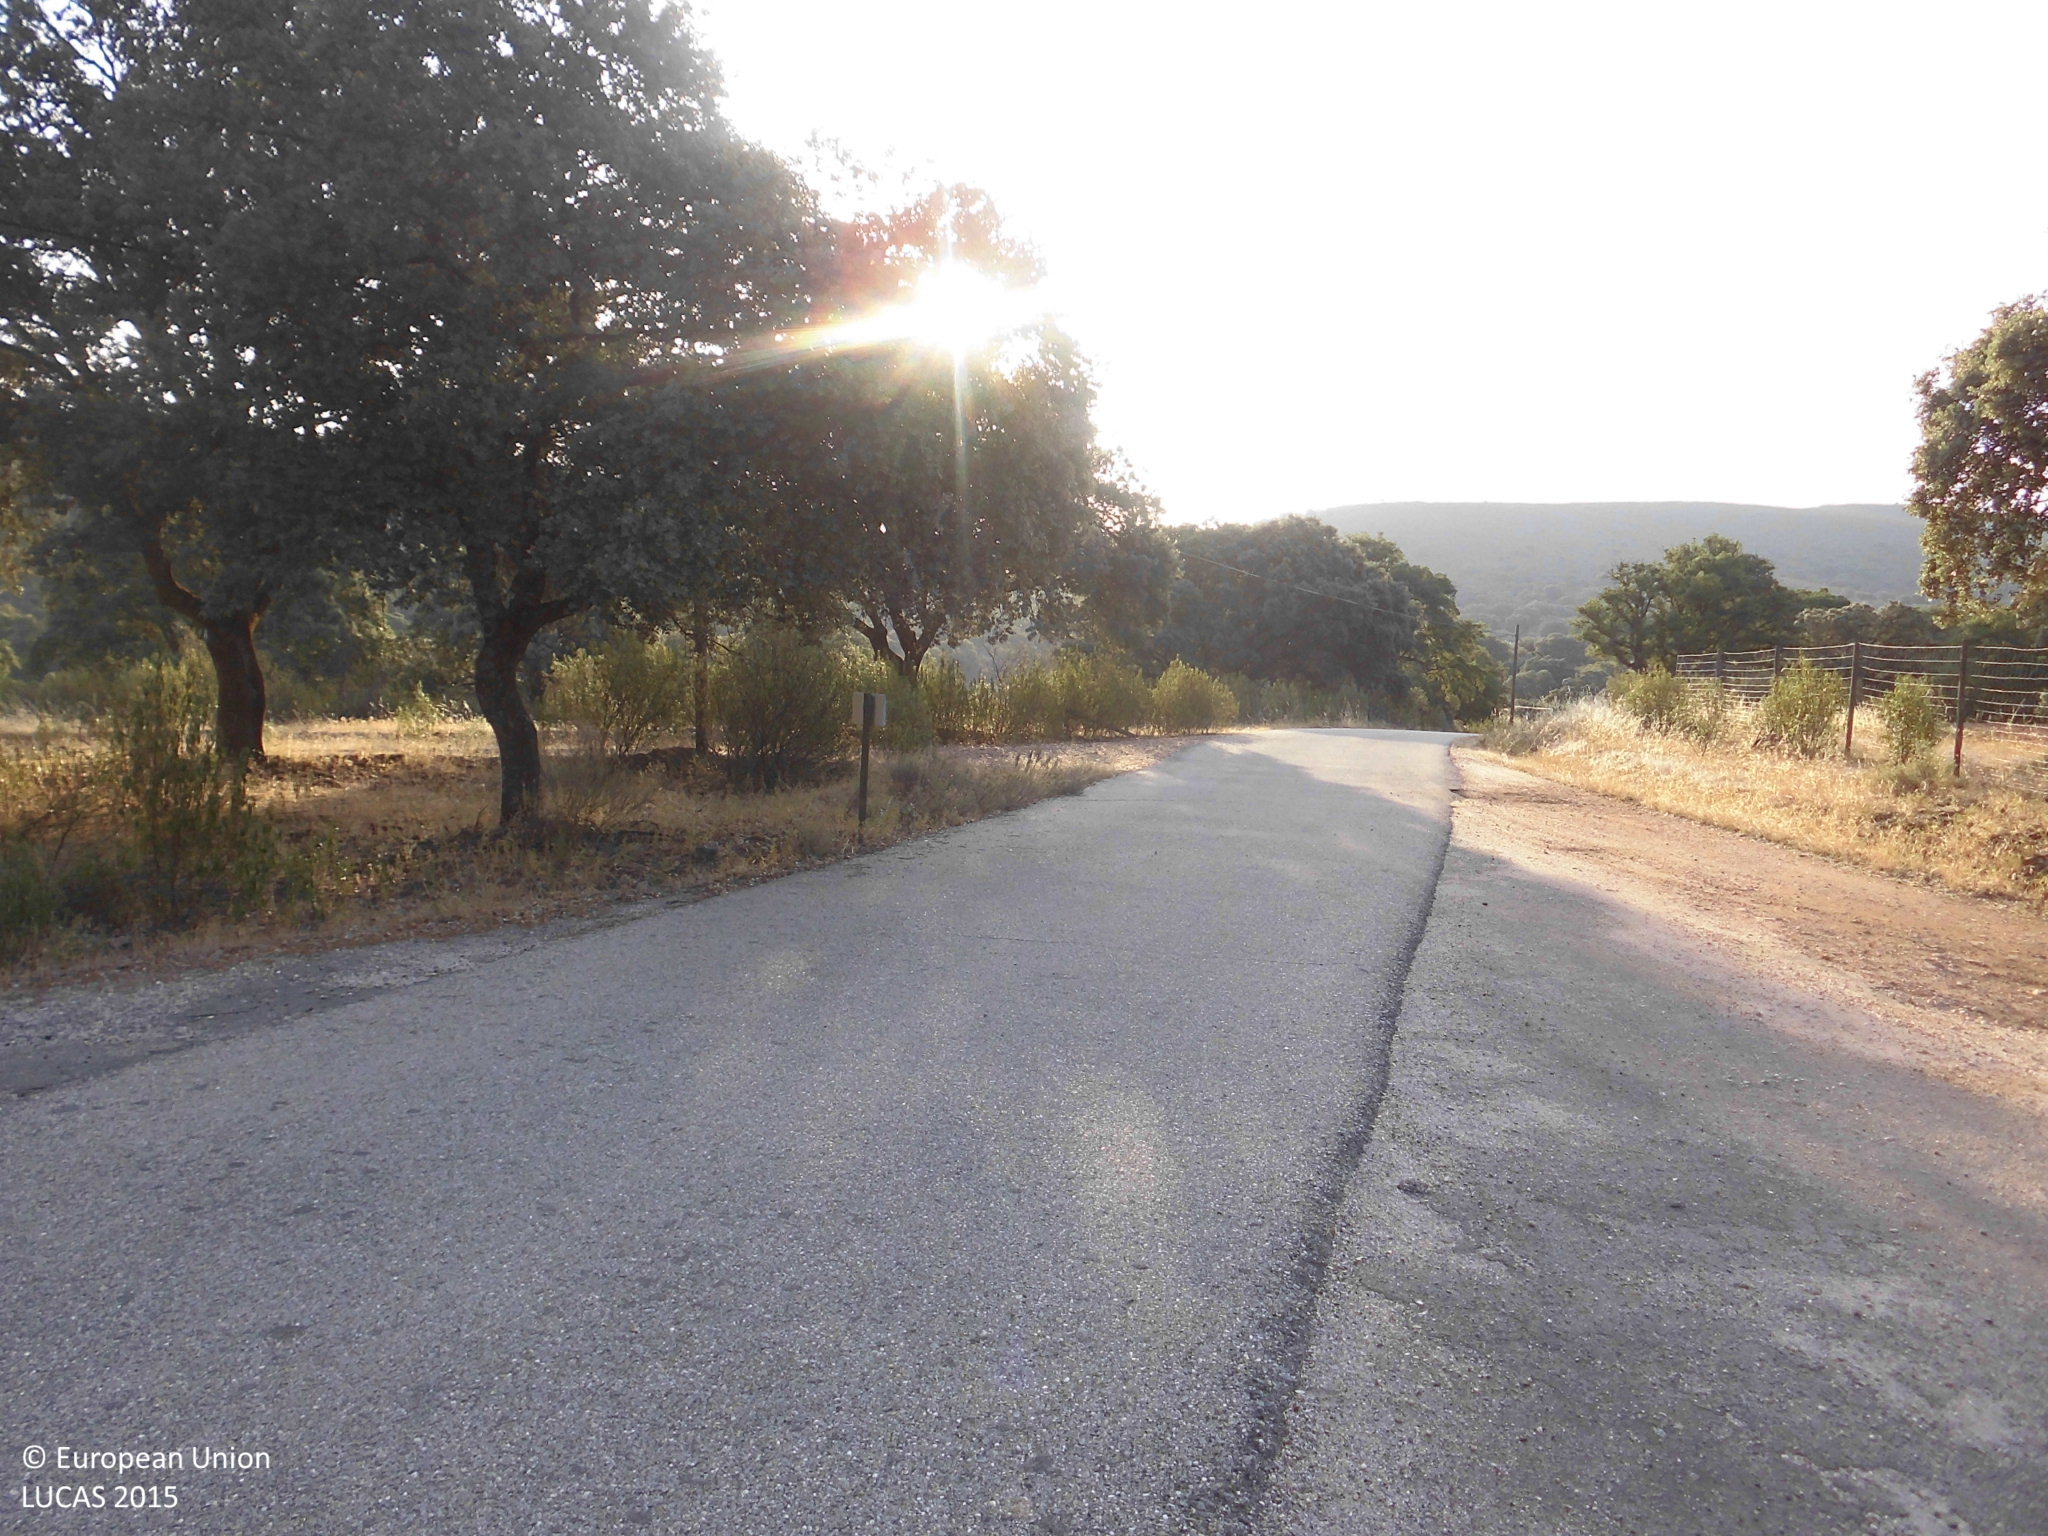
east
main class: Woodland
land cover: Broadleaved woodland
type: broadleaved evergreen forest
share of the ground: 10 - 25 %
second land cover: Grassland without tree/shrub cover
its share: > 75 %
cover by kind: herbaceous plants 85 %, broadleaved forest trees 15 %
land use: Forestry
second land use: Agriculture (excluding fallow land and kitchen gardens)
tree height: > 5 m
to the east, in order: Broadleaved woodland; Grassland without tree/shrub cover; Broadleaved woodland; Other structural elements; Tracks; Fences; Broadleaved woodland; Inland marshes; Shrubland without tree cover
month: July
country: ES
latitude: 39.8128
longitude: -5.8687
